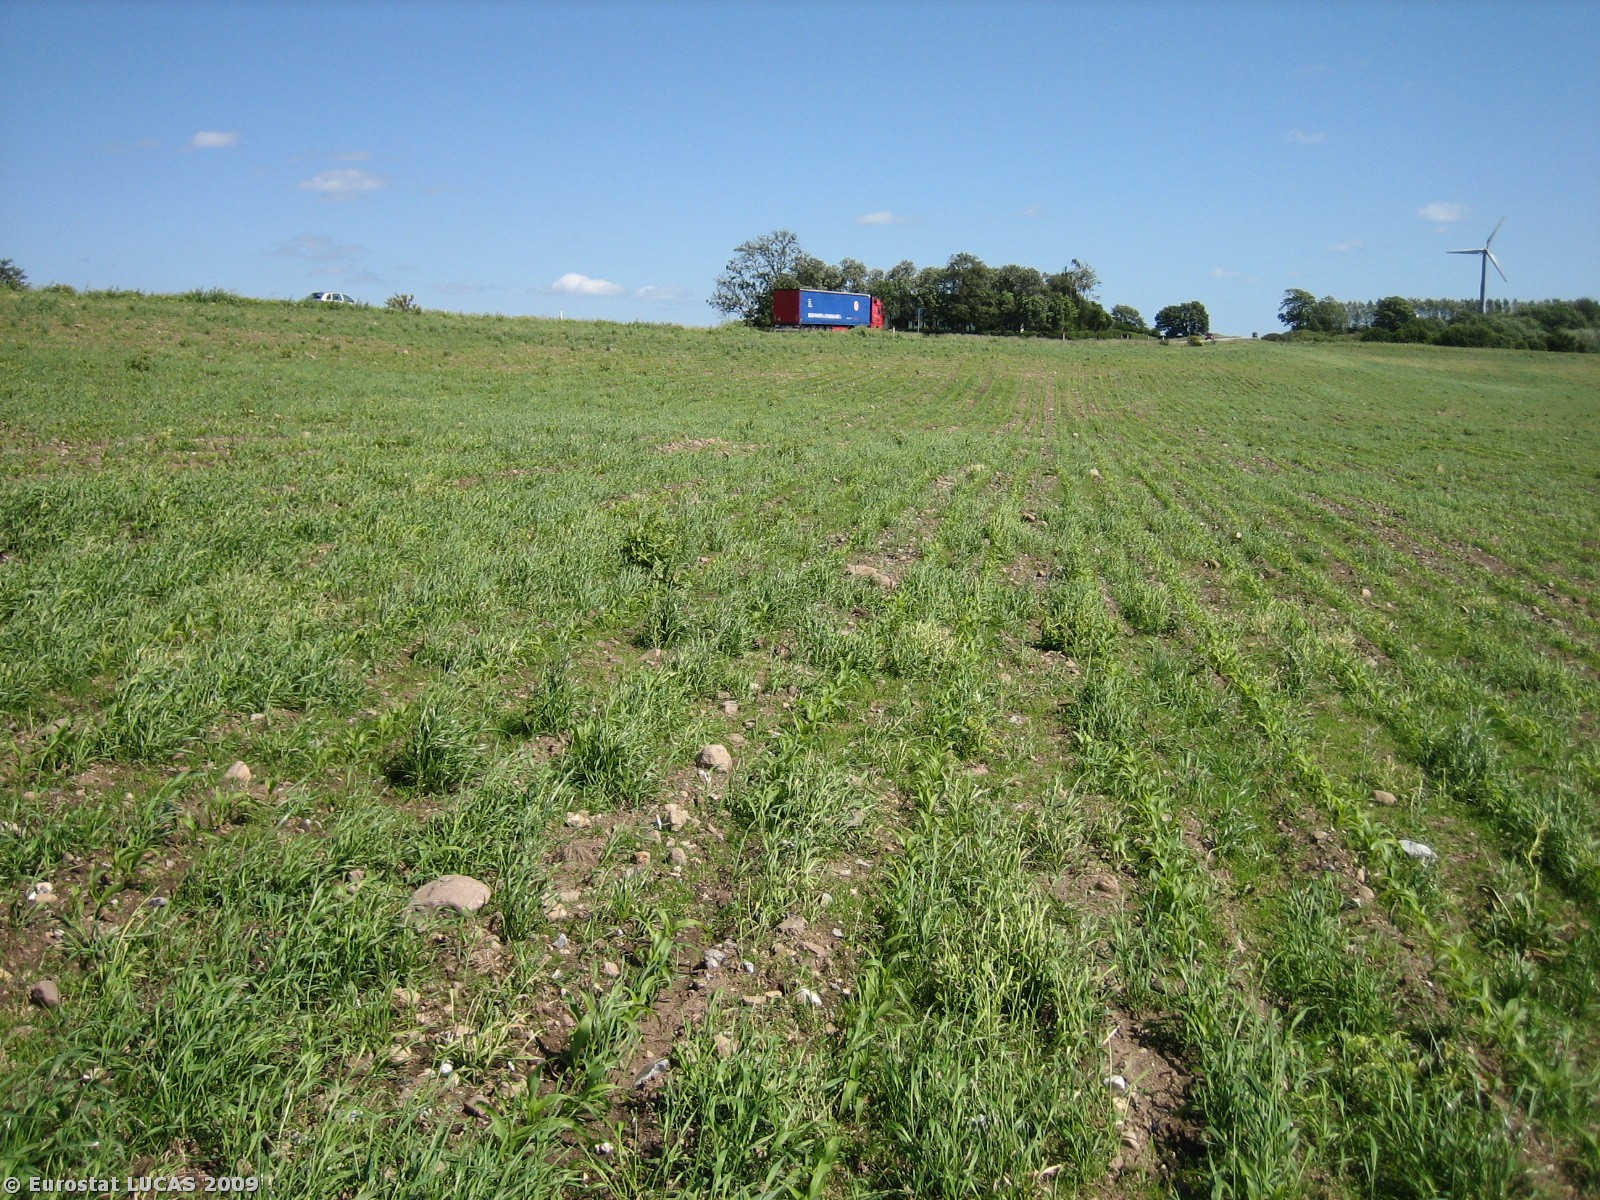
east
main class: Cropland
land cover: Maize
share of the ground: < 10 %
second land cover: Spontaneously vegetated surfaces
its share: 25 - 50 %
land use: Agriculture (excluding fallow land and kitchen gardens)
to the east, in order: Maize; Spontaneously vegetated surfaces; Grass margins; Ditches and canals; Grass margins; Tracks; Grass margins; Paved roads, cycling and walking lanes; Grass margins; Tracks; Grassland without tree/shrub cover; Rape and turnip rape; Grass margins; Tracks; Grass margins; Common wheat
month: June
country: DK
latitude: 55.9177
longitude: 9.6963
